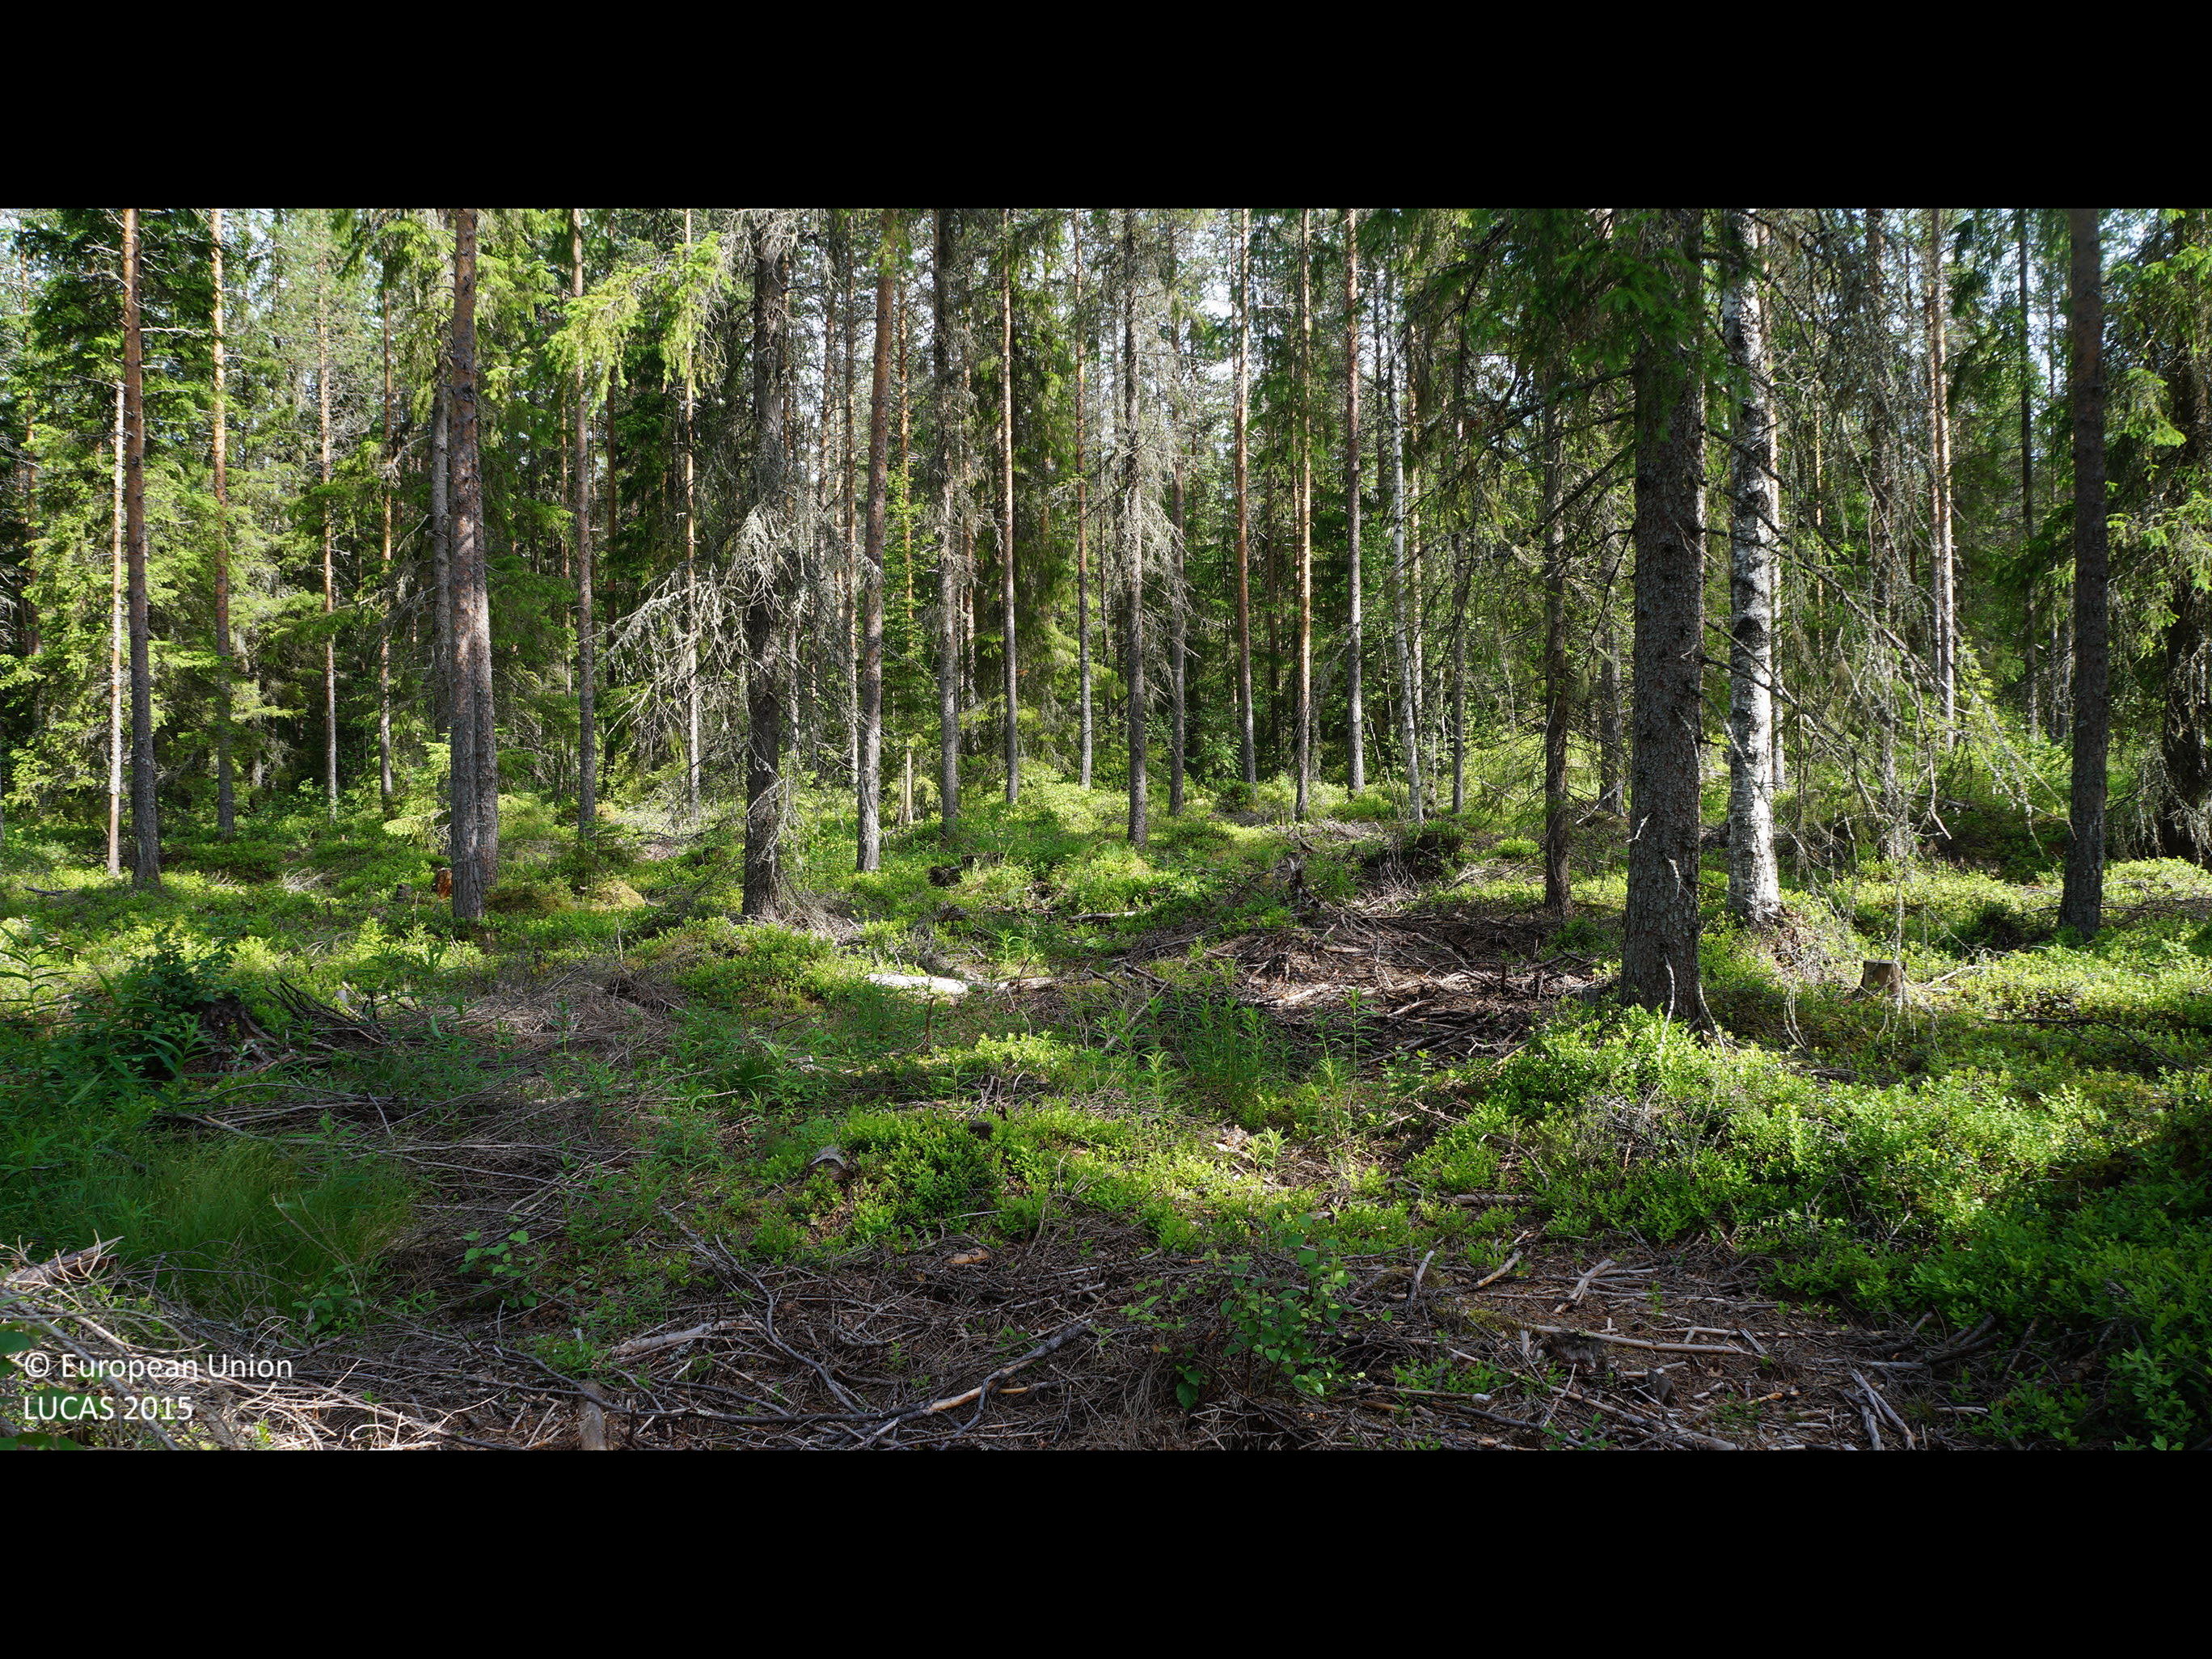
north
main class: Woodland
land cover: Spruce dominated coniferous woodland
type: boreal forest
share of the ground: 50 - 75 %
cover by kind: coniferous forest trees 50 %, shrubs 35 %, lichens and mosses 10 %, broadleaved forest trees 5 %
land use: Forestry
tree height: > 5 m
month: July
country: FI
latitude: 64.3462
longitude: 24.5847
